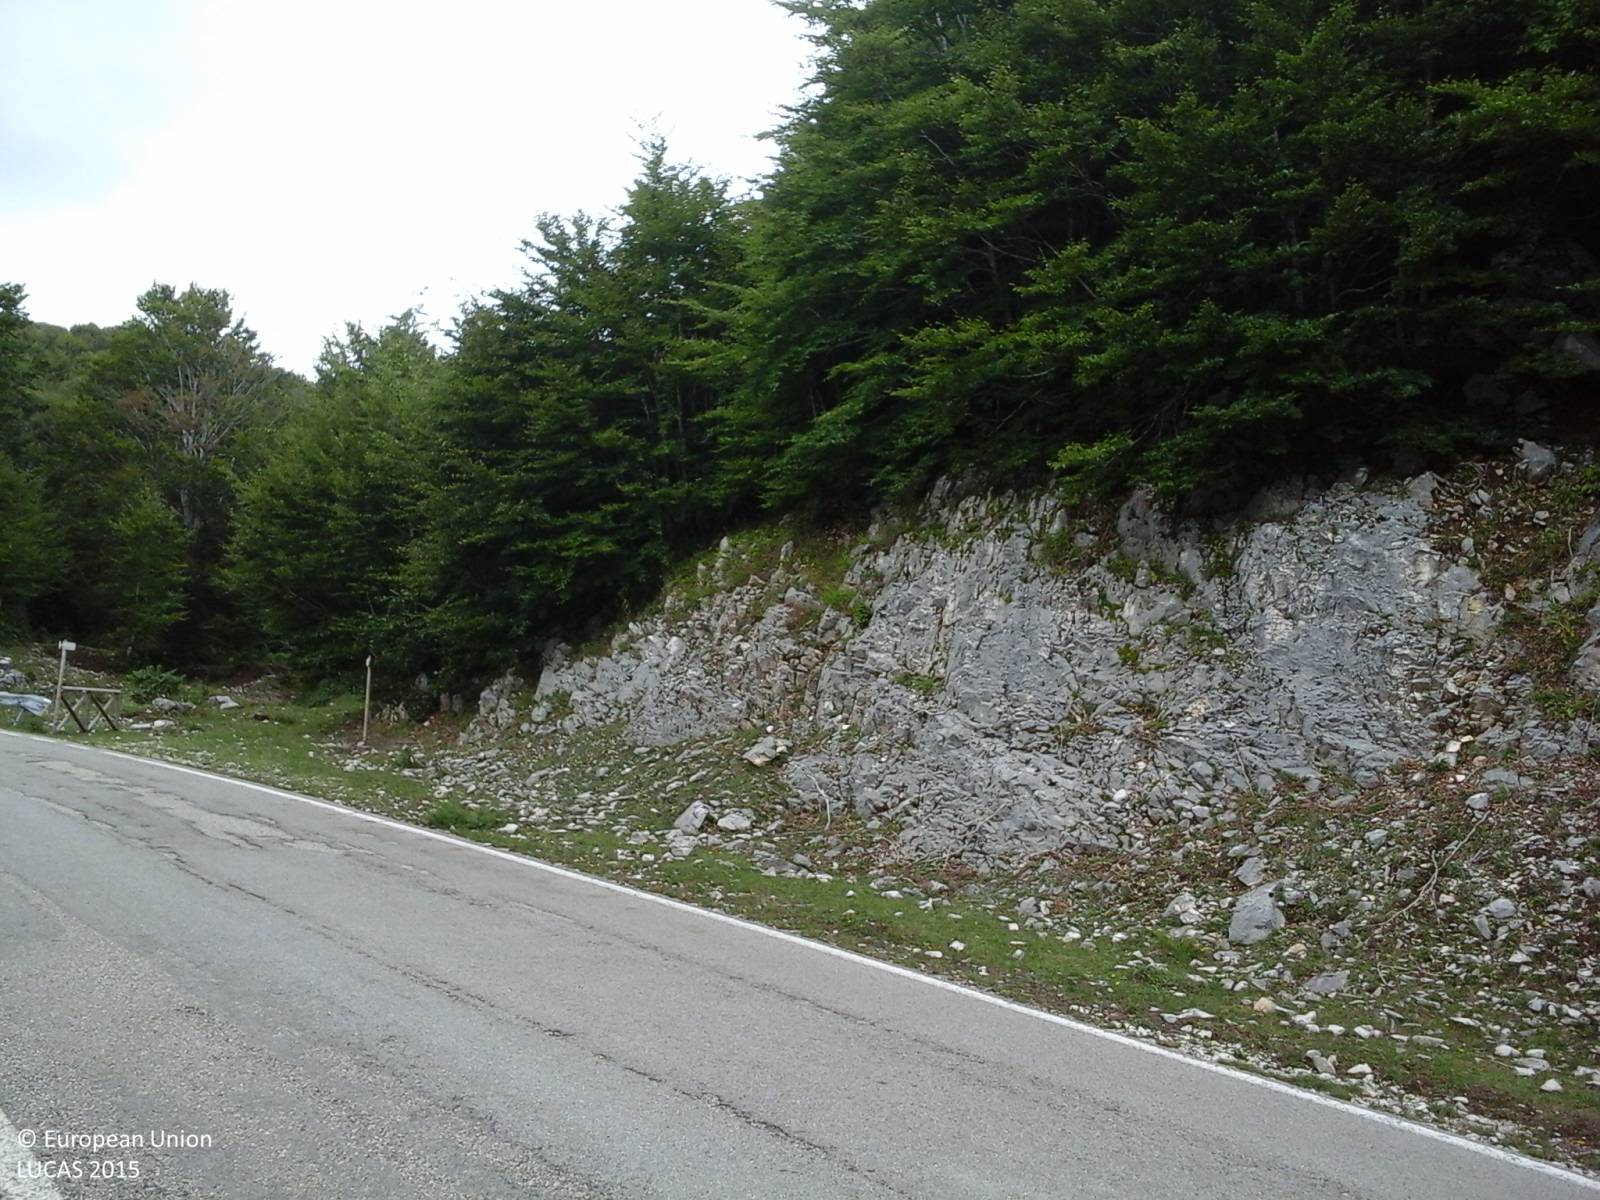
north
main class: Woodland
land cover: Broadleaved woodland
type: mountainous beech forest
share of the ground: > 75 %
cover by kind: broadleaved forest trees 100 %
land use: Semi-natural and natural areas not in use
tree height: > 5 m
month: August
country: IT
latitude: 41.4154
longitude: 14.4701
